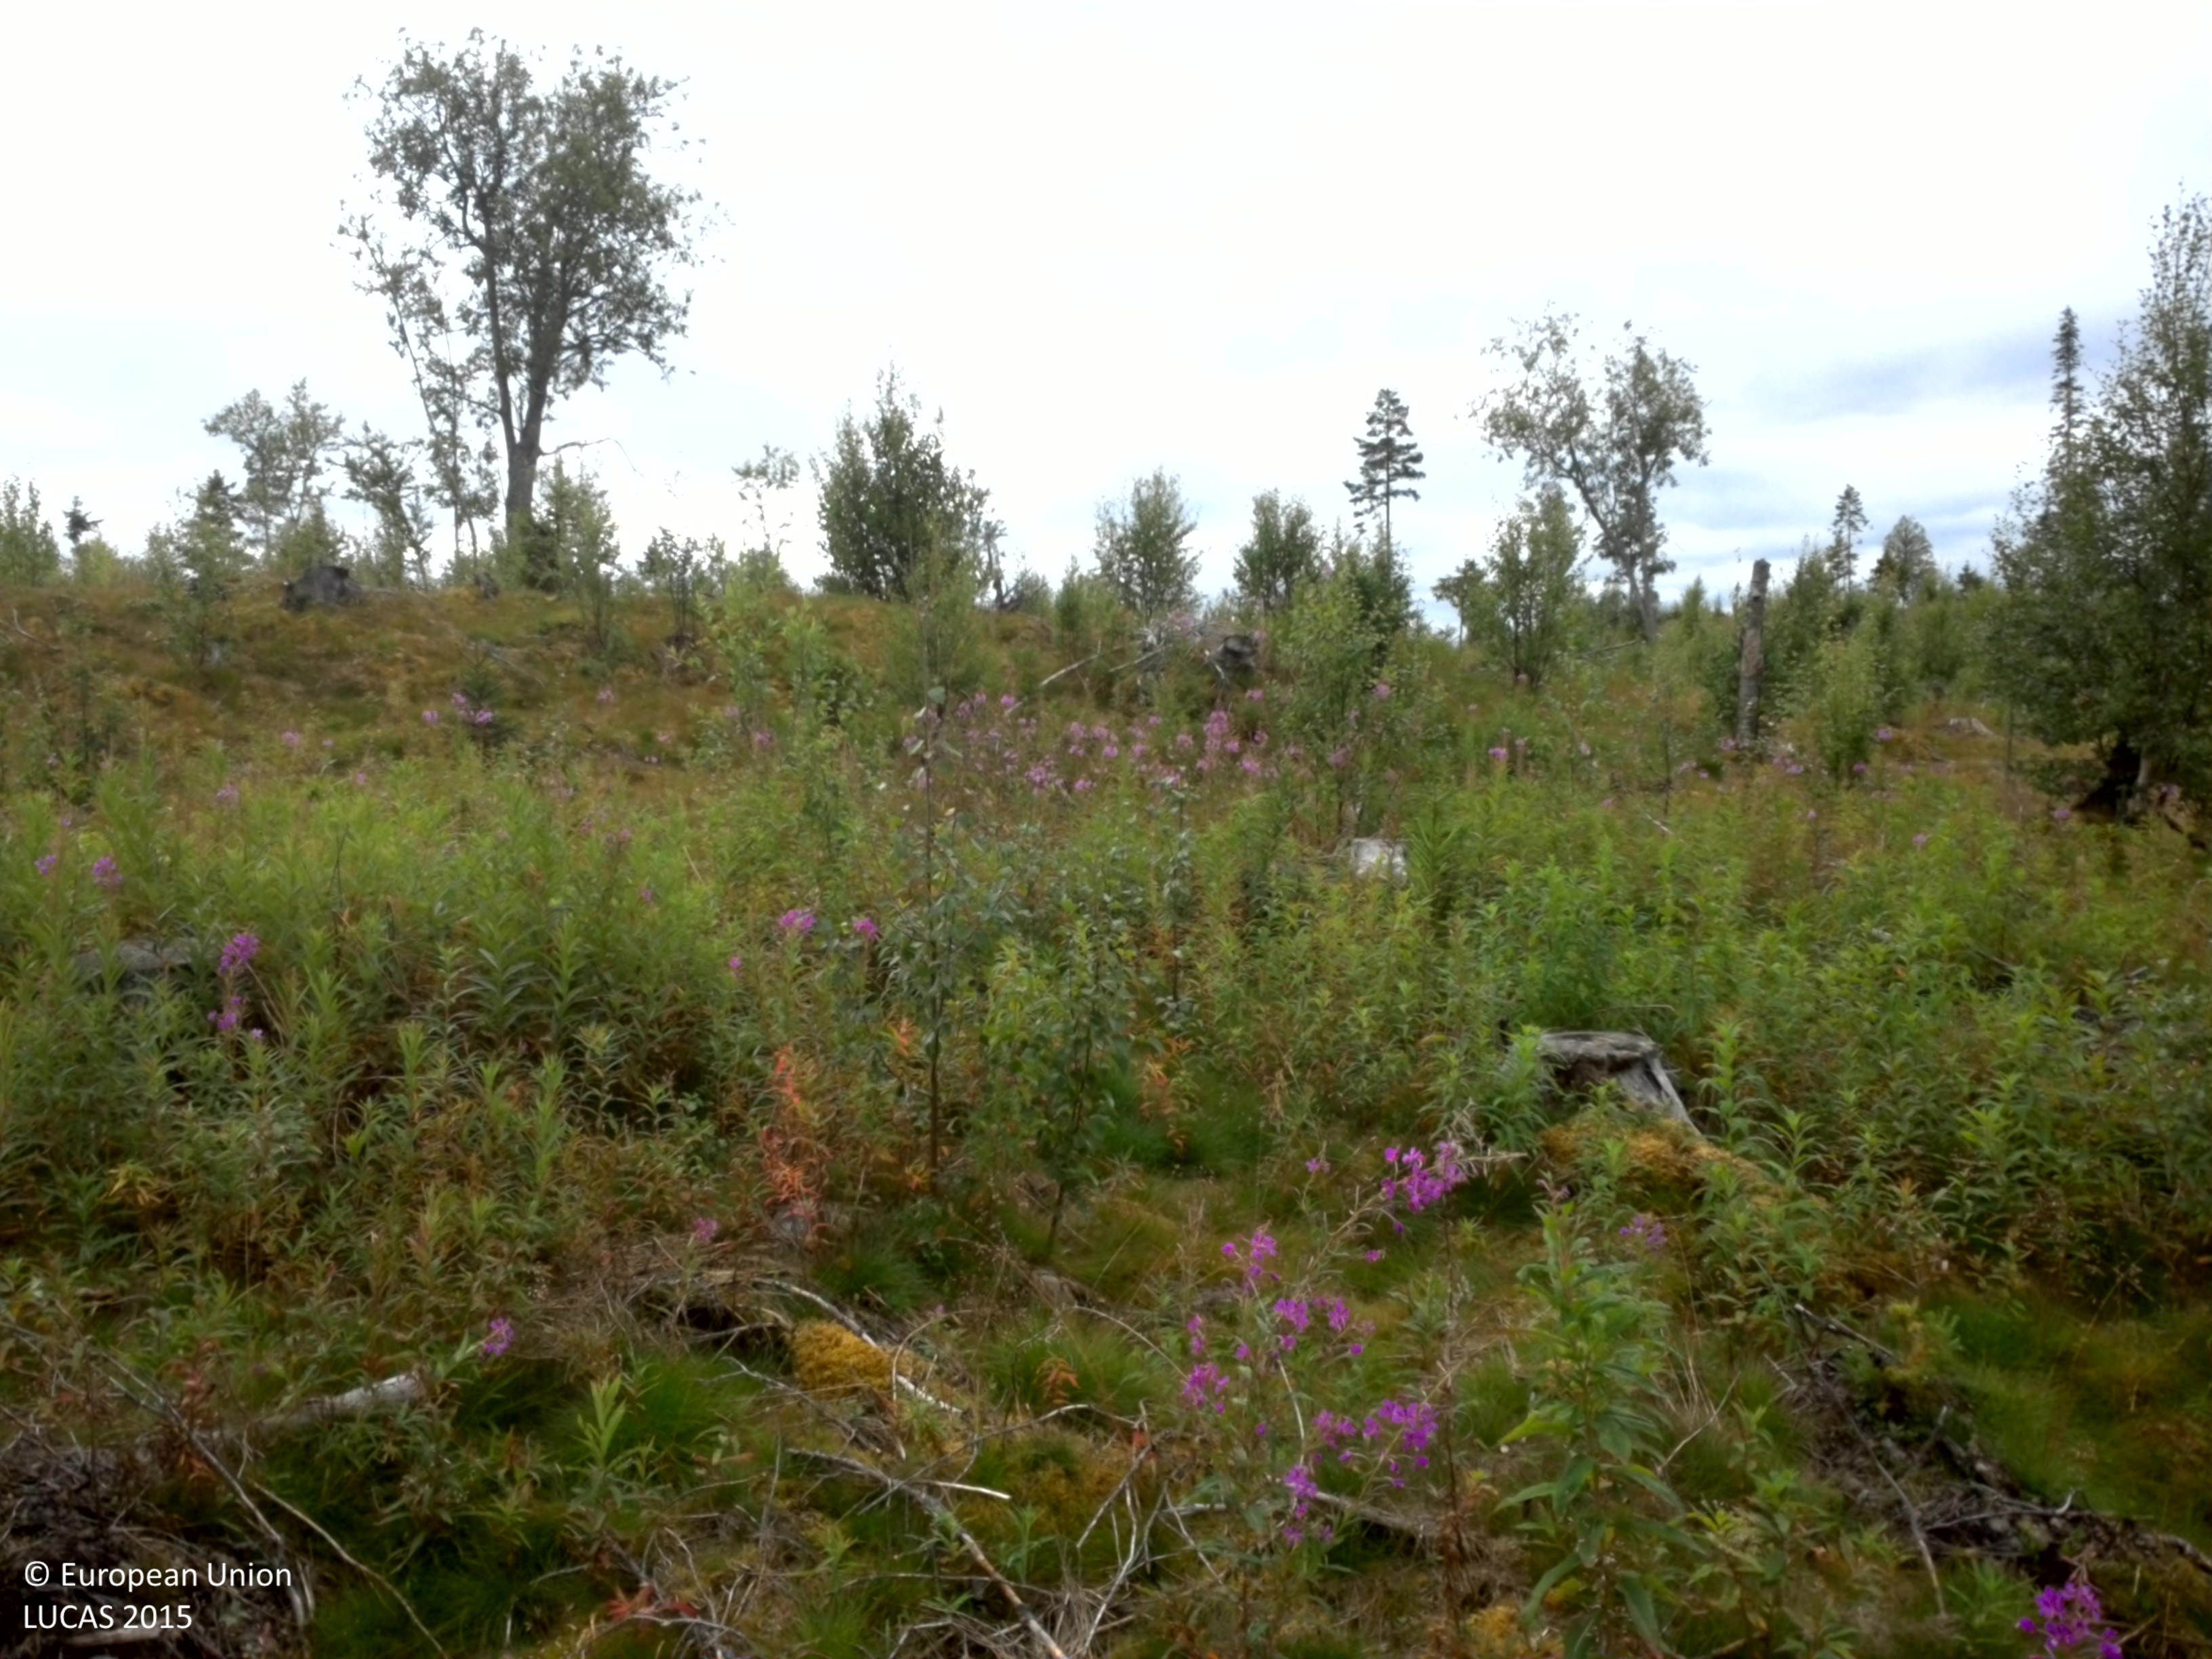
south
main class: Grassland
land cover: Grassland with sparse tree/shrub cover
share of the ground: > 75 %
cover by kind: herbaceous plants 80 %, broadleaved forest trees 5 %, shrubs 5 %, lichens and mosses 5 %
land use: Forestry
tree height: < 5 m
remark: Clear cut
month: August
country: SE
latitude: 64.7869
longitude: 16.5933
